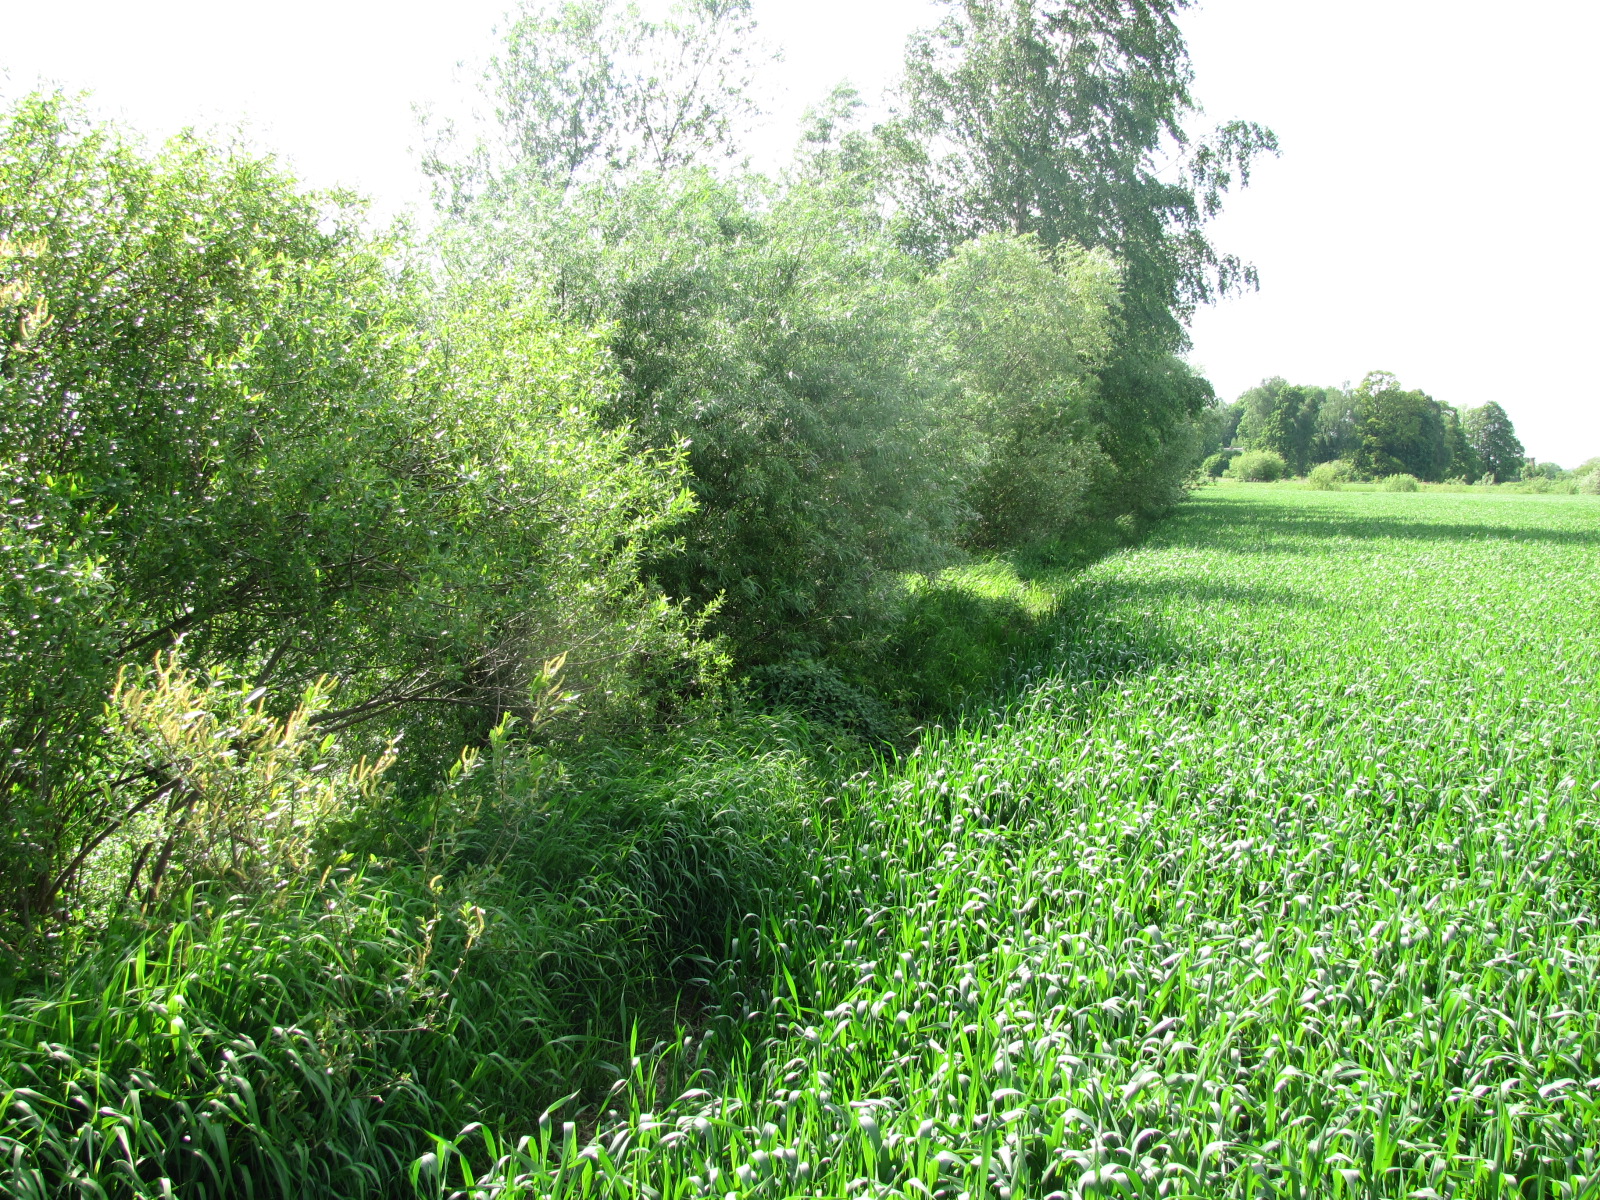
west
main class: Cropland
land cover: Common wheat
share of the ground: > 75 %
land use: Agriculture (excluding fallow land and kitchen gardens)
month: May
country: LV
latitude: 56.5774
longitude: 23.9033
